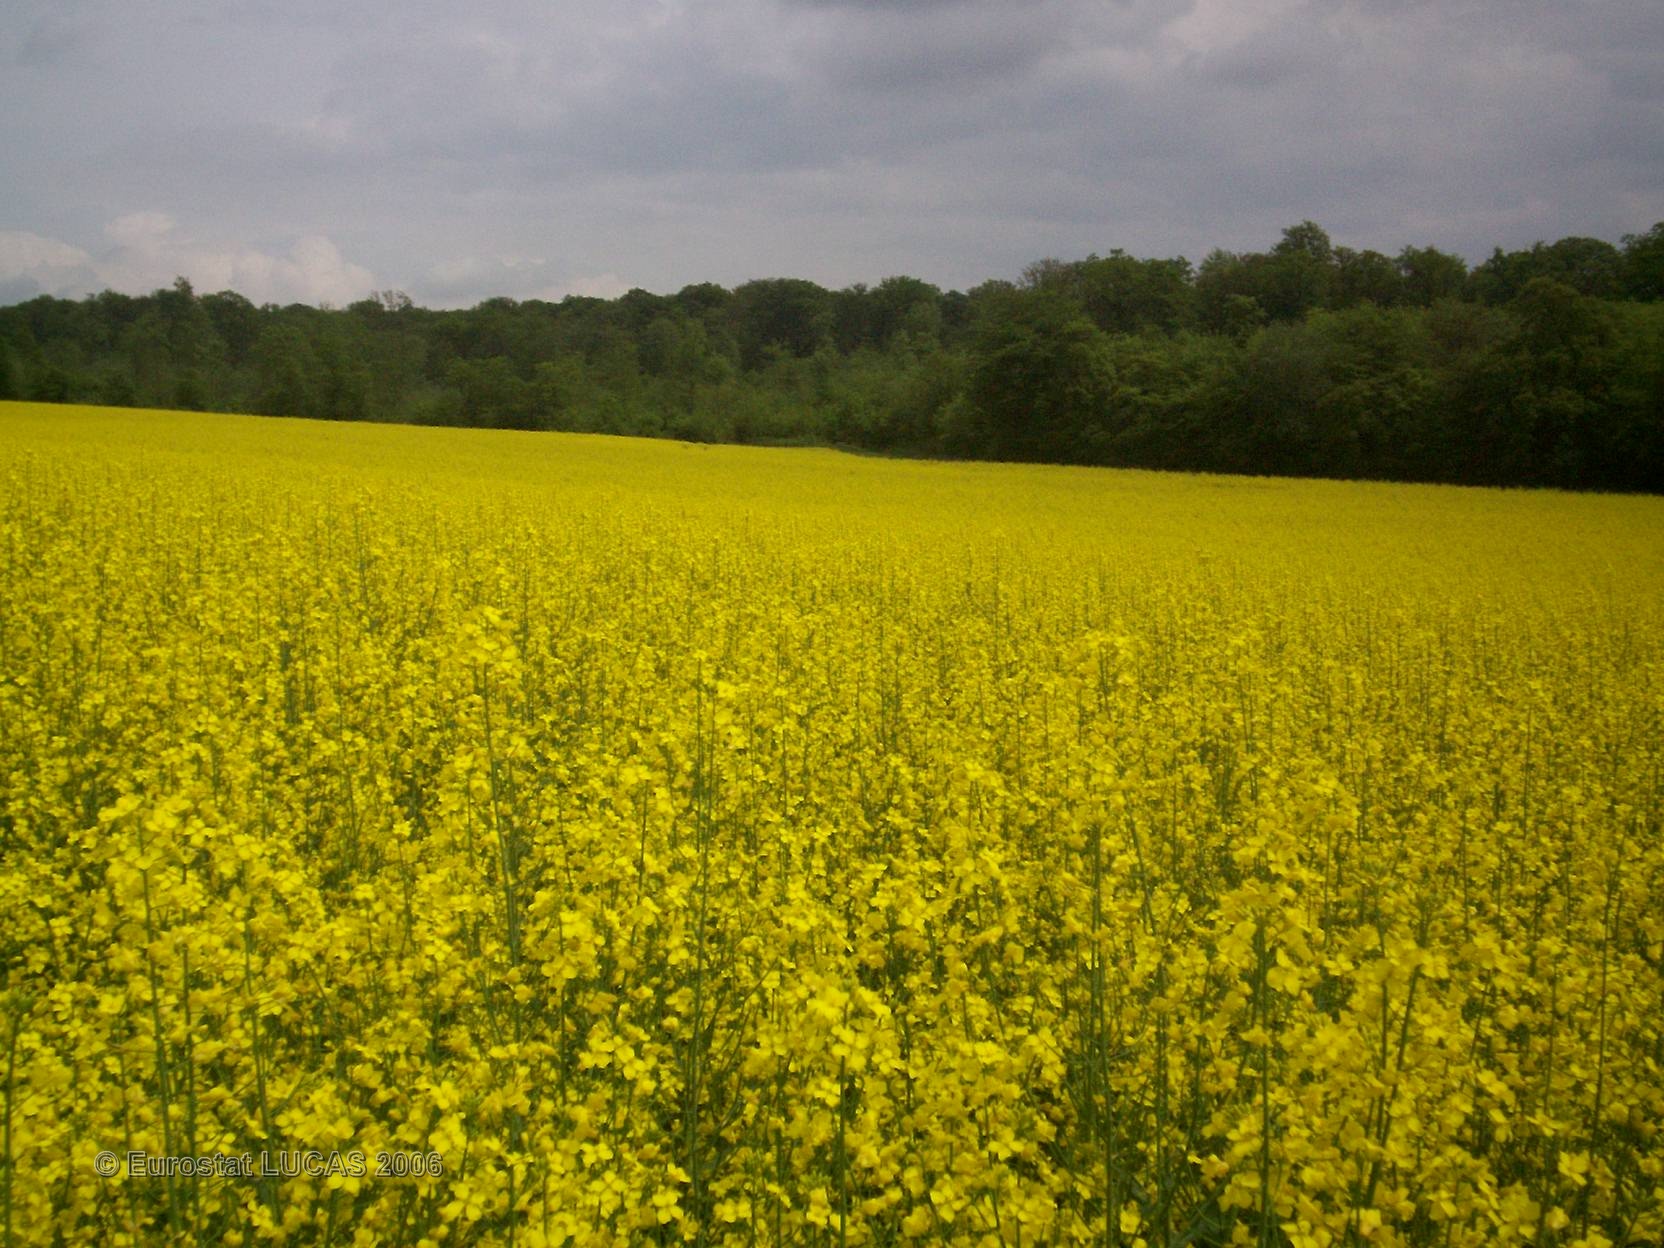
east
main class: Cropland
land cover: Rape and turnip rape
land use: Agriculture (excluding fallow land and kitchen gardens)
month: May
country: FR
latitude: 49.3895
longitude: 6.4040
